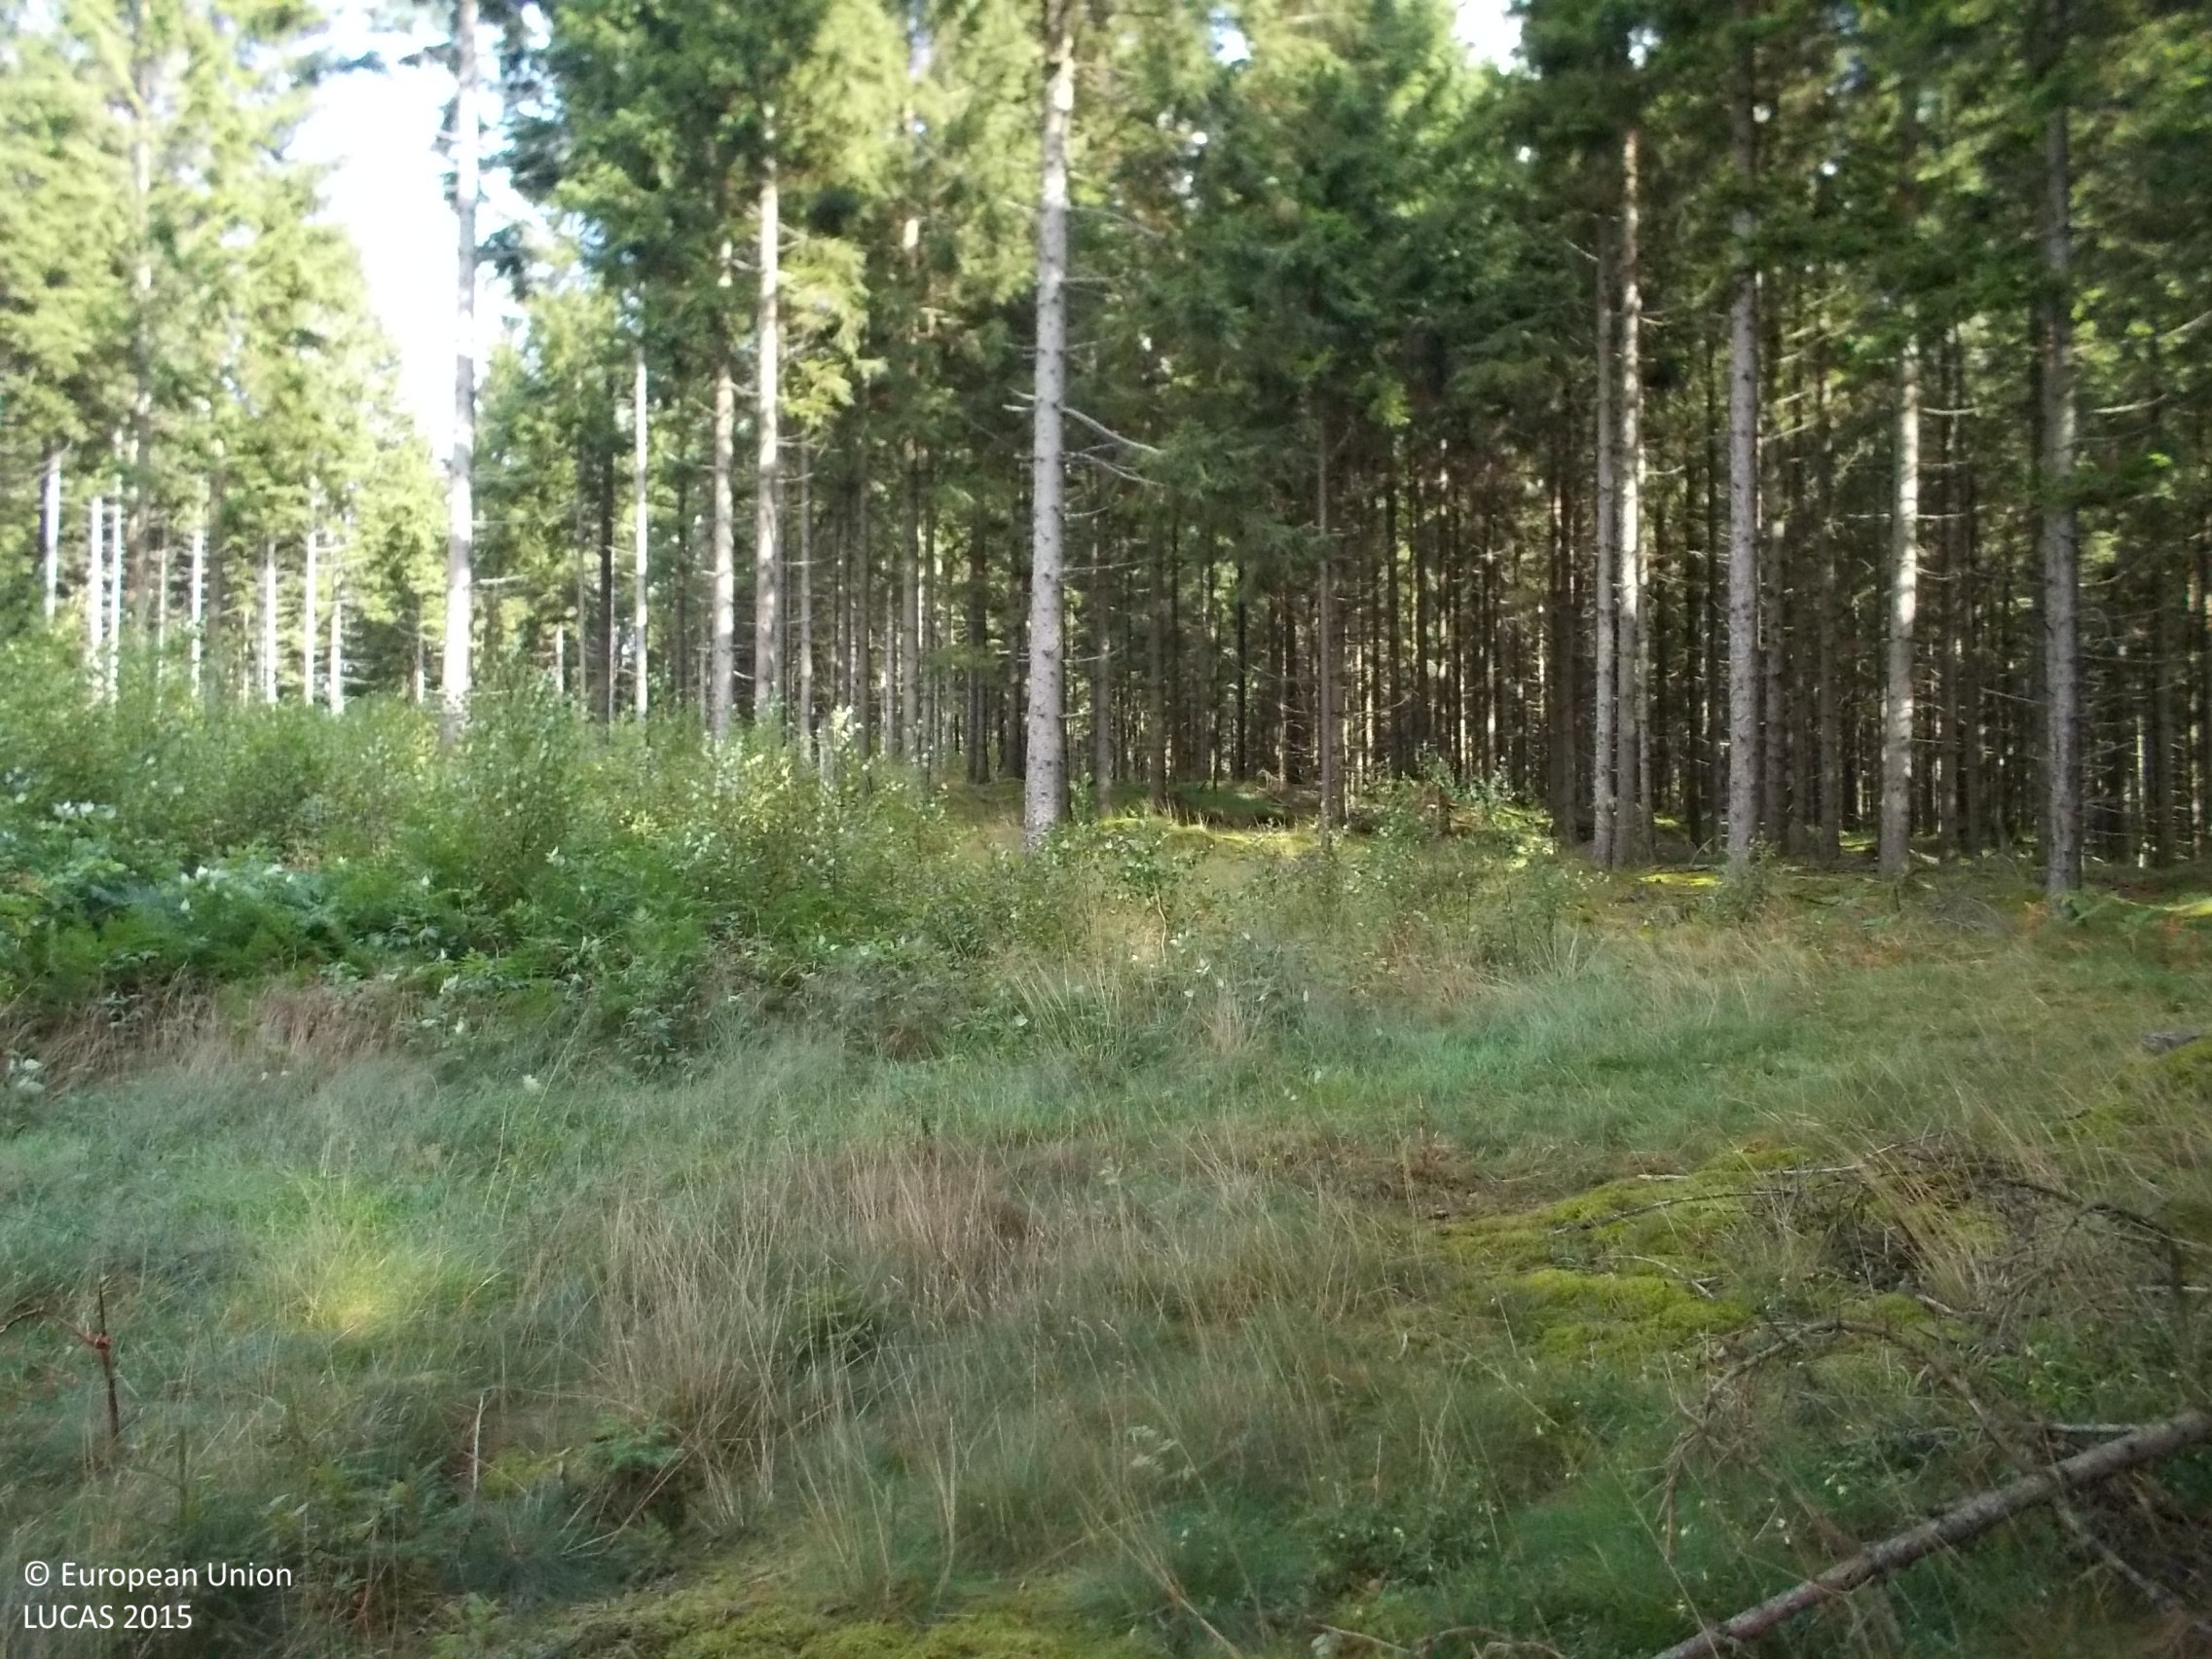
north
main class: Woodland
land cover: Spruce dominated coniferous woodland
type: boreal forest
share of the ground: > 75 %
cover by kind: coniferous forest trees 85 %, lichens and mosses 10 %, herbaceous plants 5 %
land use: Forestry
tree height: < 5 m
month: August
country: SE
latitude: 57.7720
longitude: 13.0049
